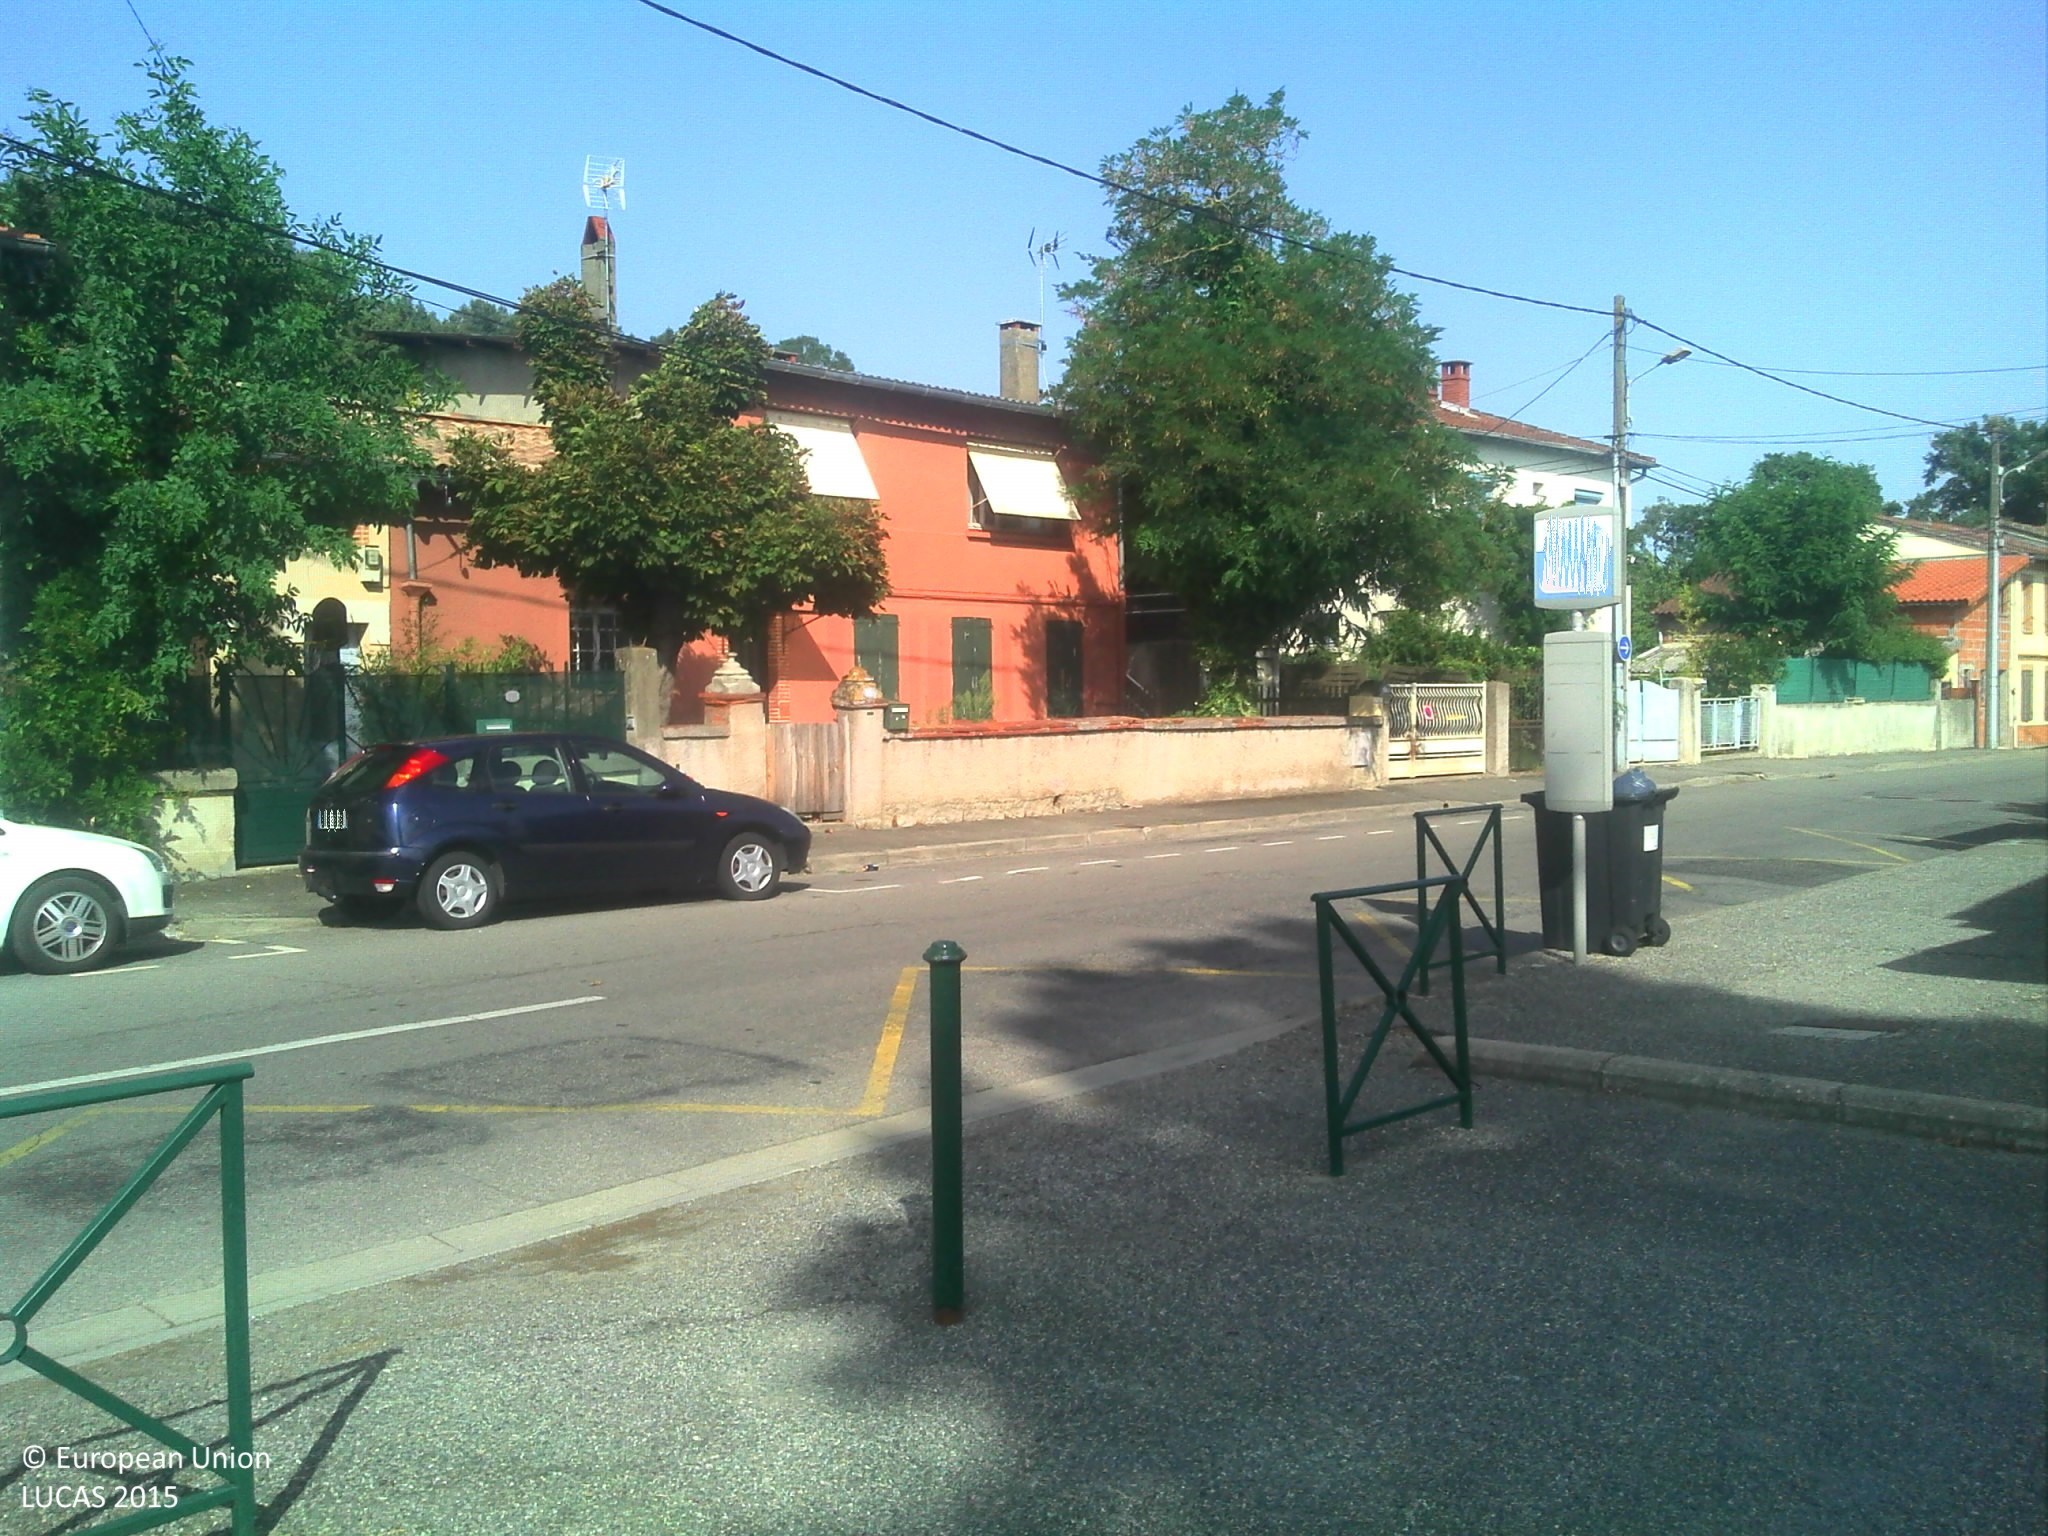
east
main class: Grassland
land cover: Grassland without tree/shrub cover
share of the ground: > 75 %
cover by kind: herbaceous plants 100 %
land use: Community services
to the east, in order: Grassland without tree/shrub cover; Artificial constructions in urban areas; Broadleaved woodland; Artificial constructions in urban areas
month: August
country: FR
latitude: 43.5219
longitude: 1.4044
